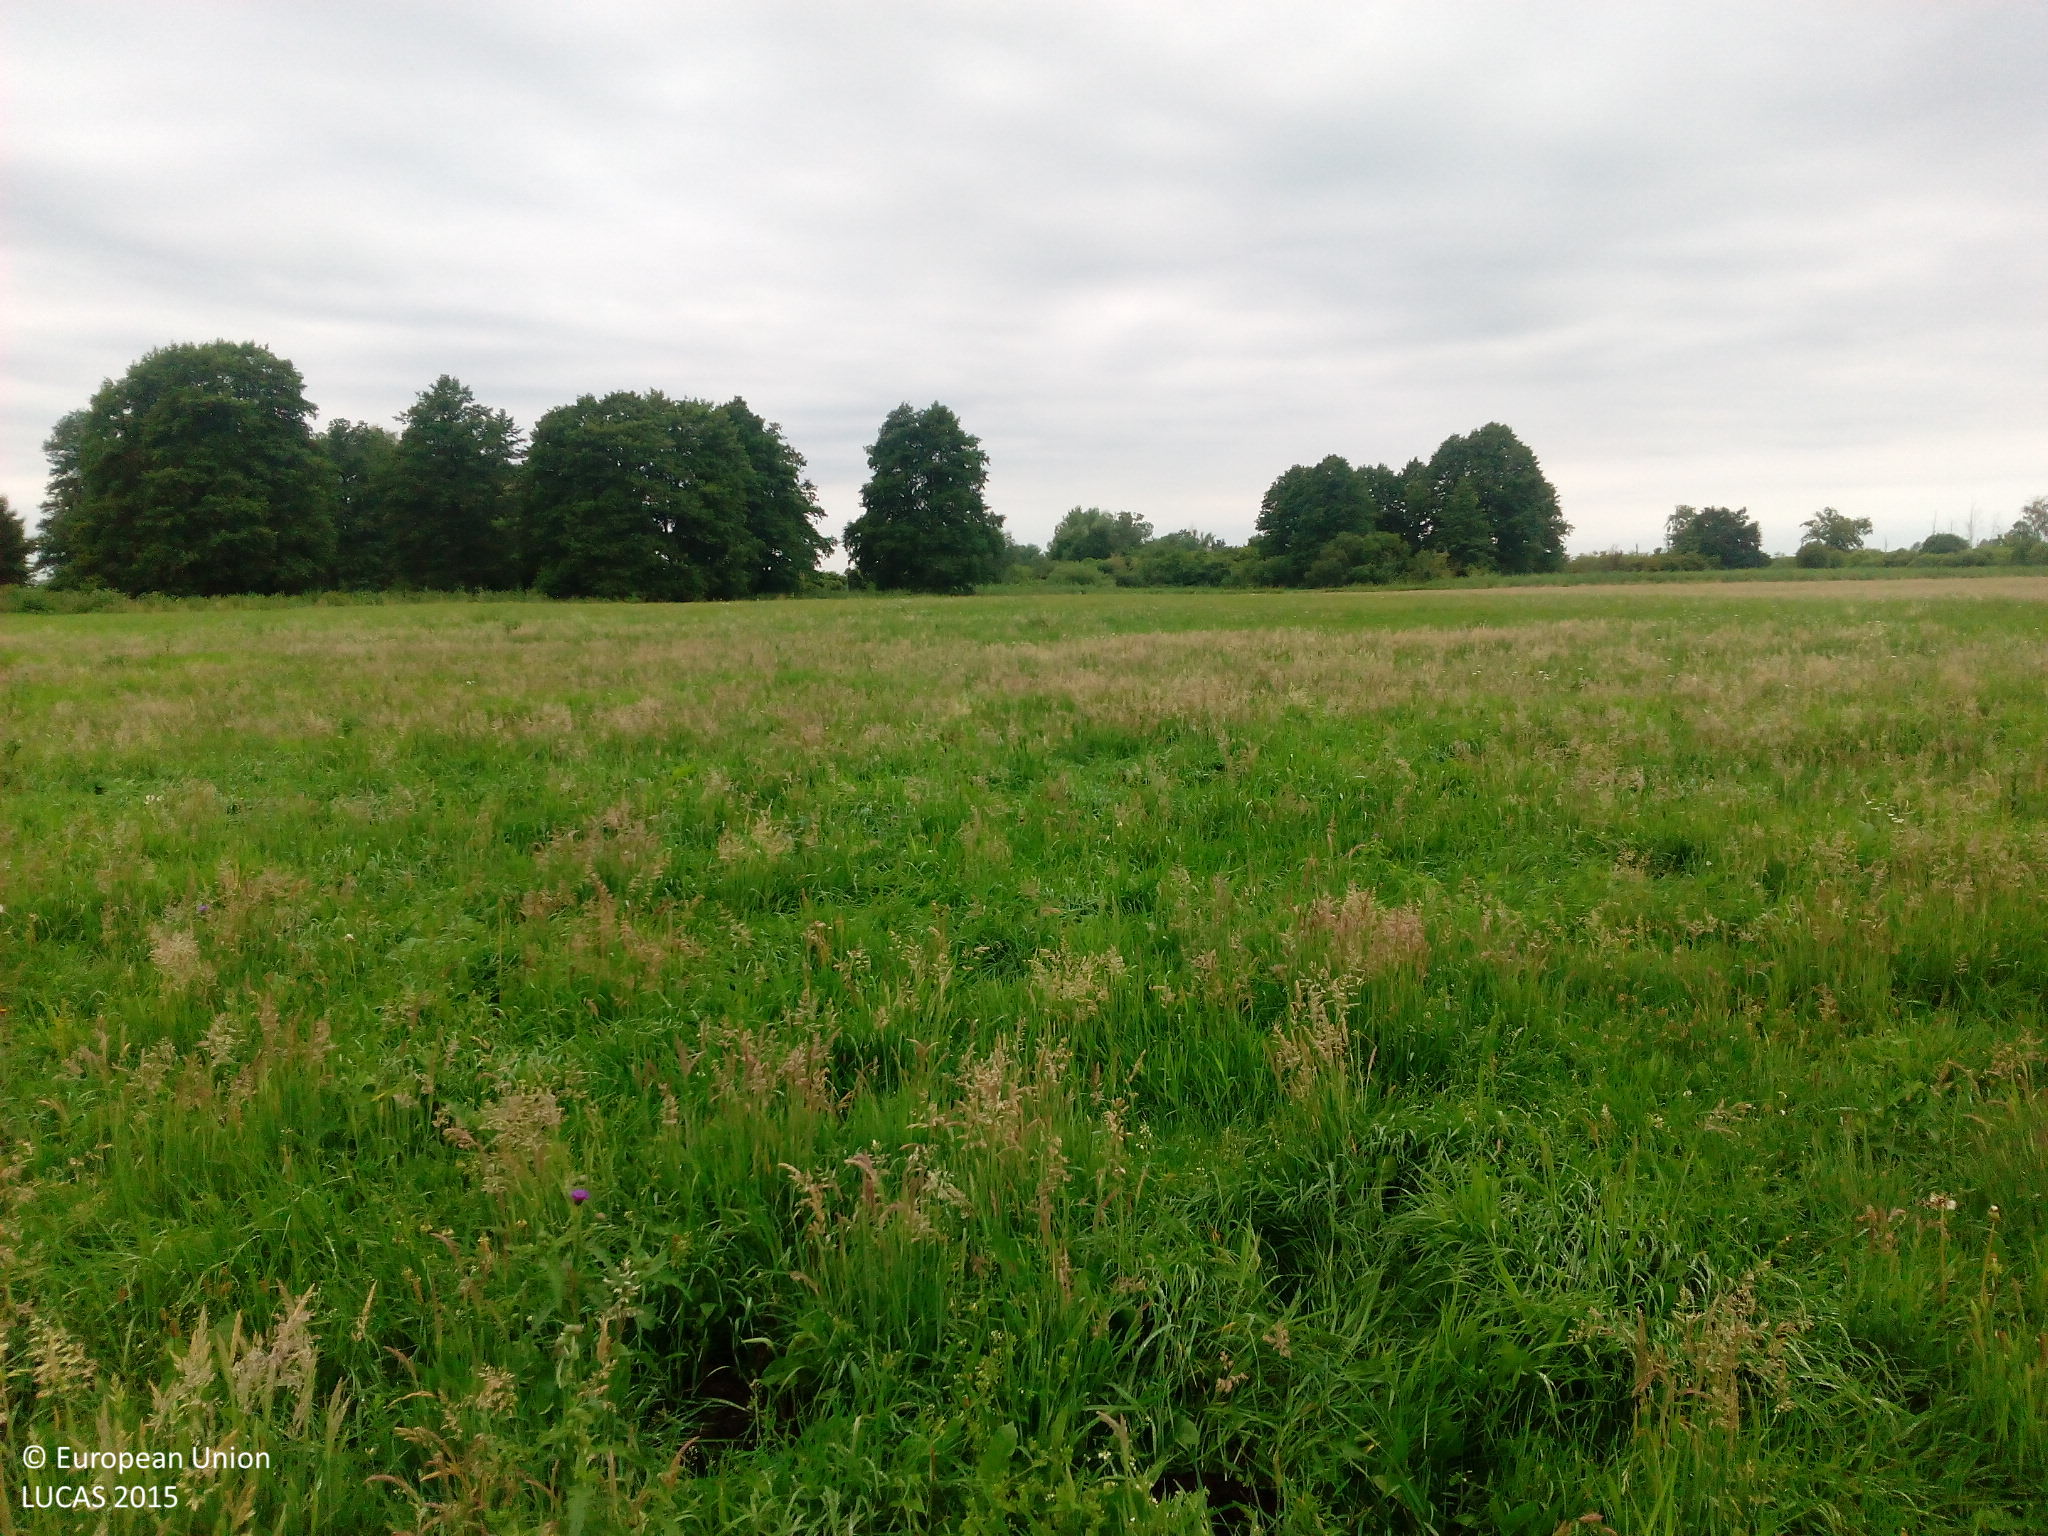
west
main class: Grassland
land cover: Grassland without tree/shrub cover
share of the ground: > 75 %
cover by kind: herbaceous plants 100 %
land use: Agriculture (excluding fallow land and kitchen gardens)
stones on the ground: < 10 %
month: July
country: DE
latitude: 53.5448
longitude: 14.2111
